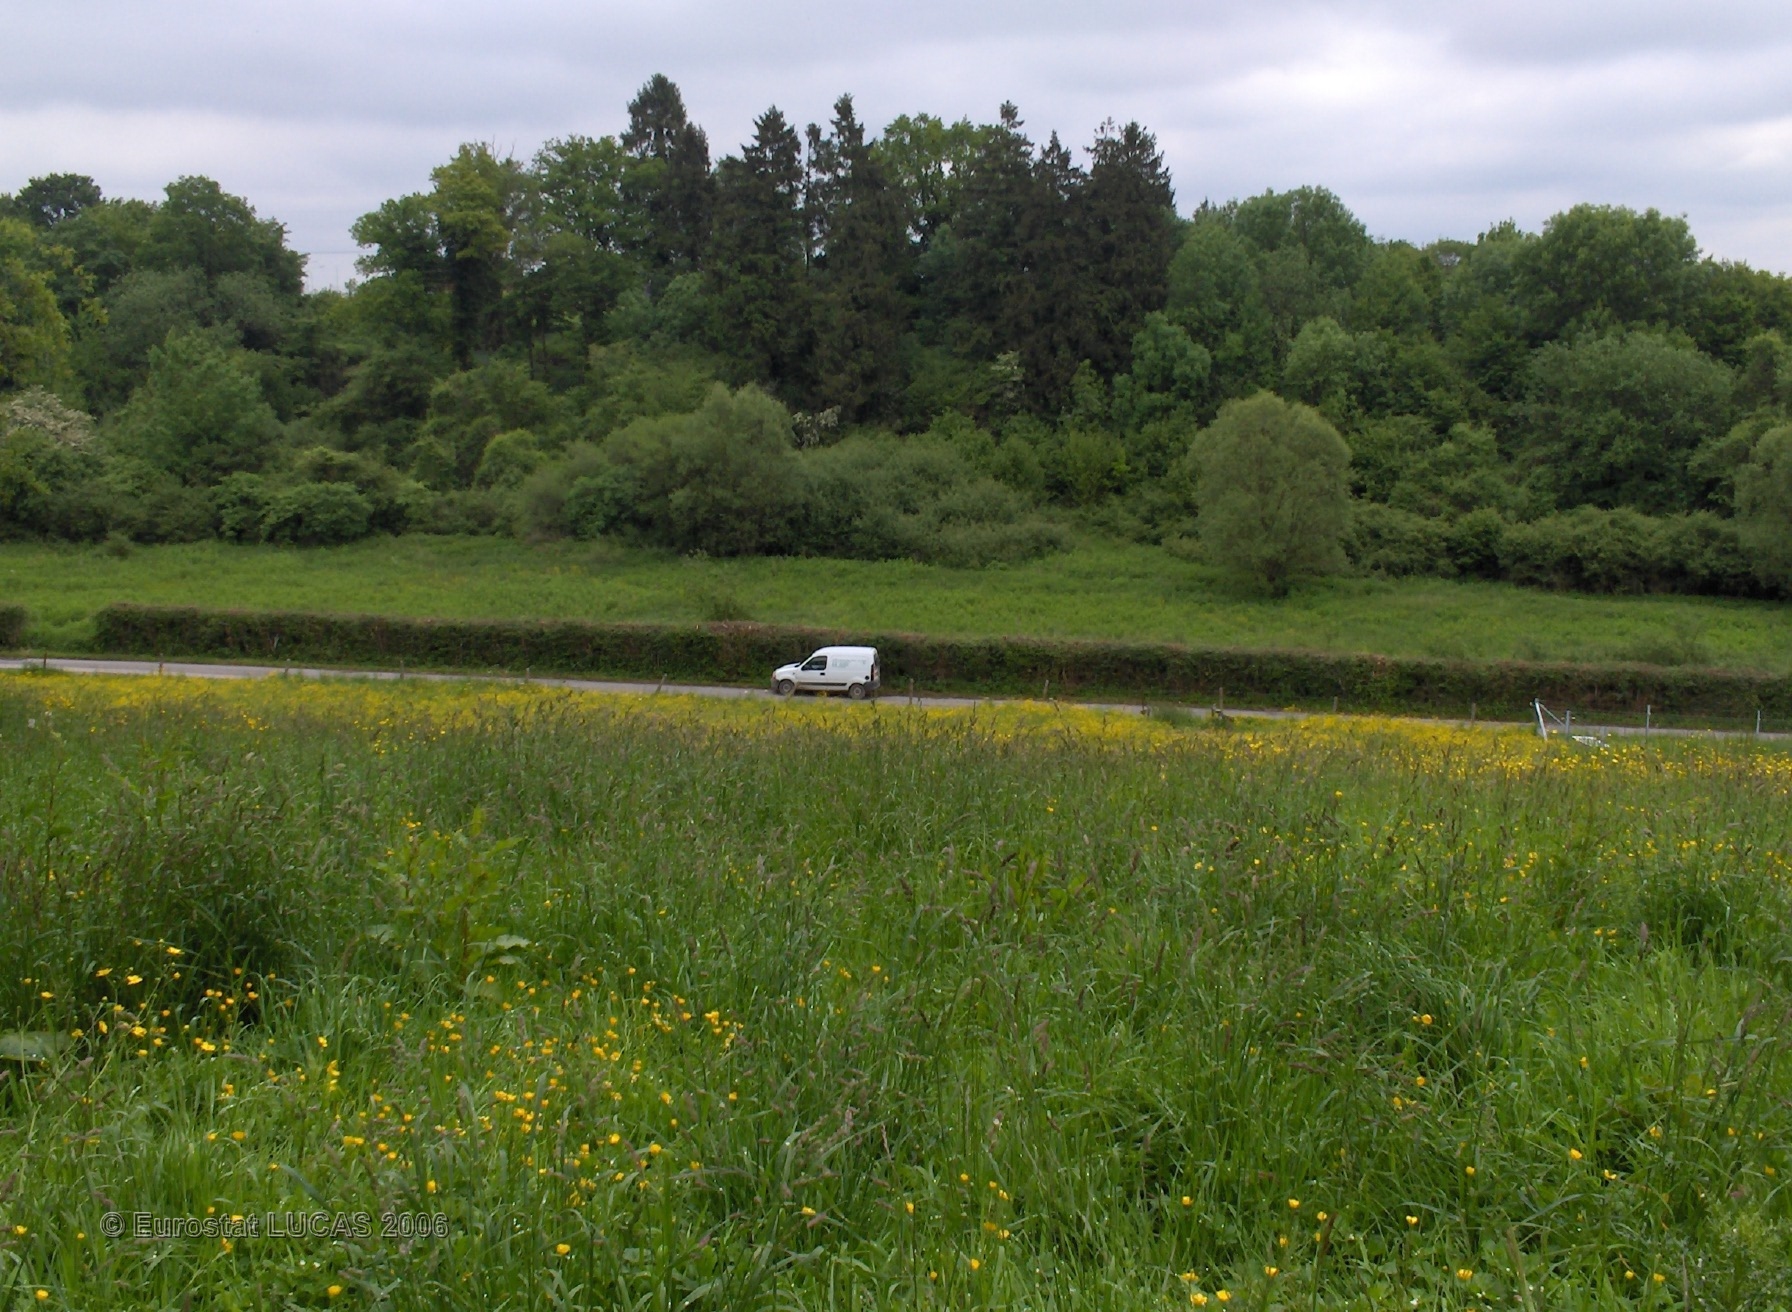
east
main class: Grassland
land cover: Grassland without tree/shrub cover
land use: Agriculture (excluding fallow land and kitchen gardens)
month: June
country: BE
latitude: 50.1787
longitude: 4.5207
